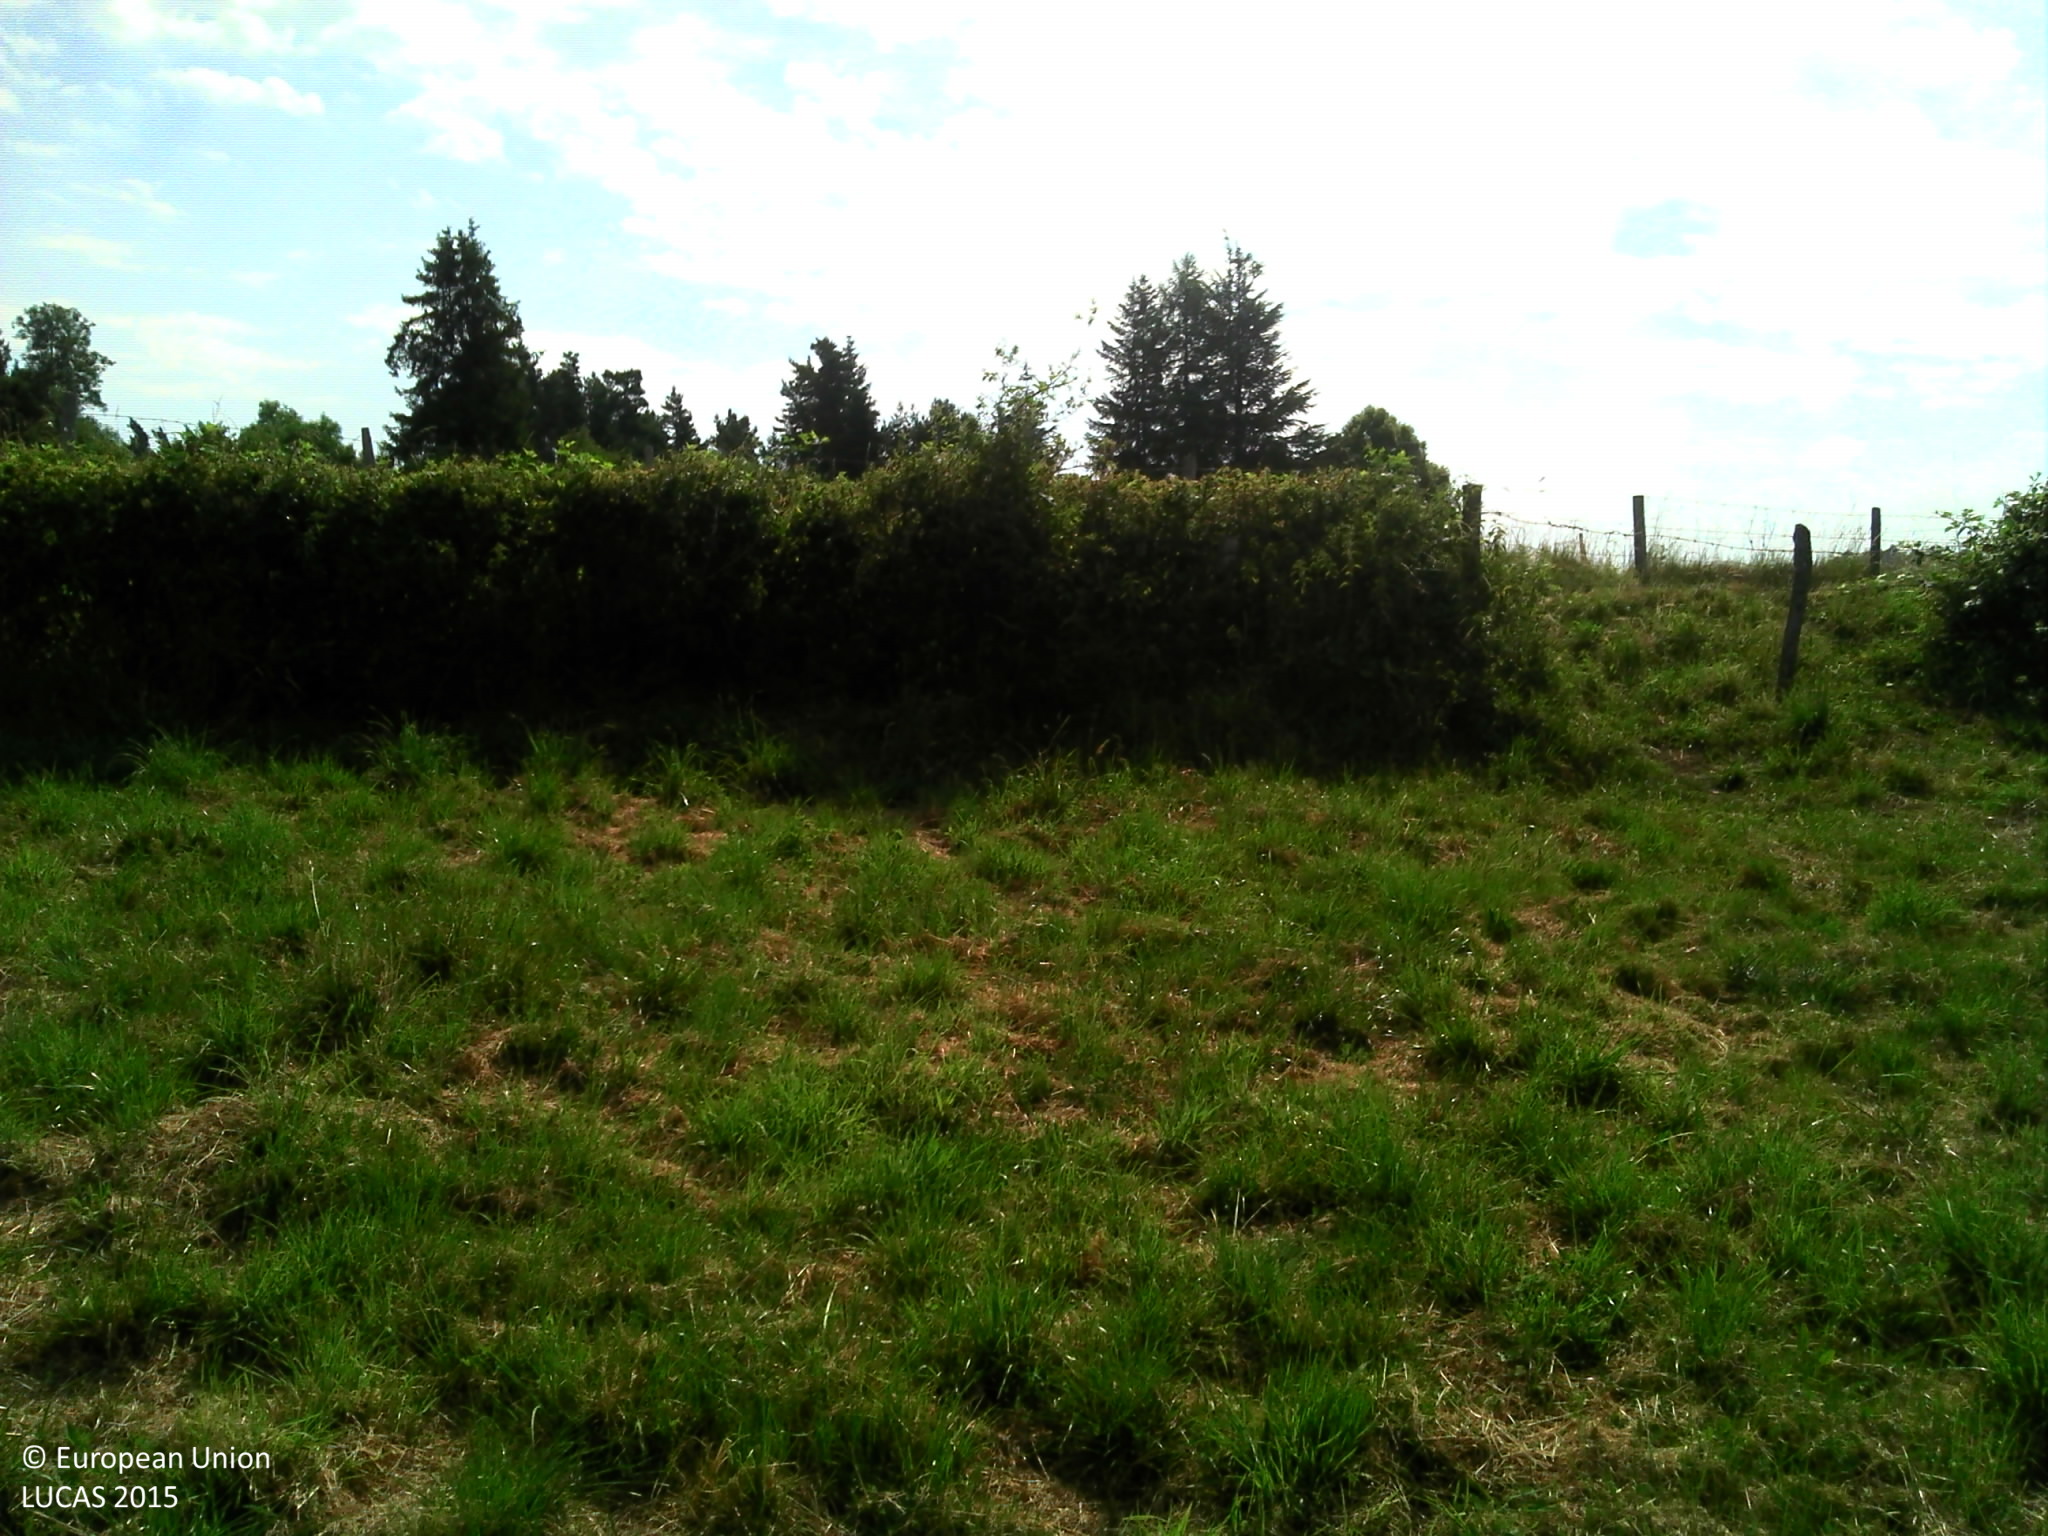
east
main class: Grassland
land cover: Grassland without tree/shrub cover
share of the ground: > 75 %
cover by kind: herbaceous plants 100 %
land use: Agriculture (excluding fallow land and kitchen gardens)
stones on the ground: < 10 %
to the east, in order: Grassland without tree/shrub cover; Abandoned hedges; Fences; Grass margins; Paved roads, cycling and walking lanes; Grass margins; Ditches and canals; Grass margins; Fences; Grassland without tree/shrub cover; Abandoned hedges; Fences; Shrubland without tree cover; Tracks; Shrubland without tree cover; Lines of trees; Grass margins; Ditches and canals; Grass margins; Paved roads, cycling and walking lanes; Grass margins; Fences; Electric lines; Lines of trees; Grassland without tree/shrub cover
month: July
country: FR
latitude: 44.8528
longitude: 2.9545
